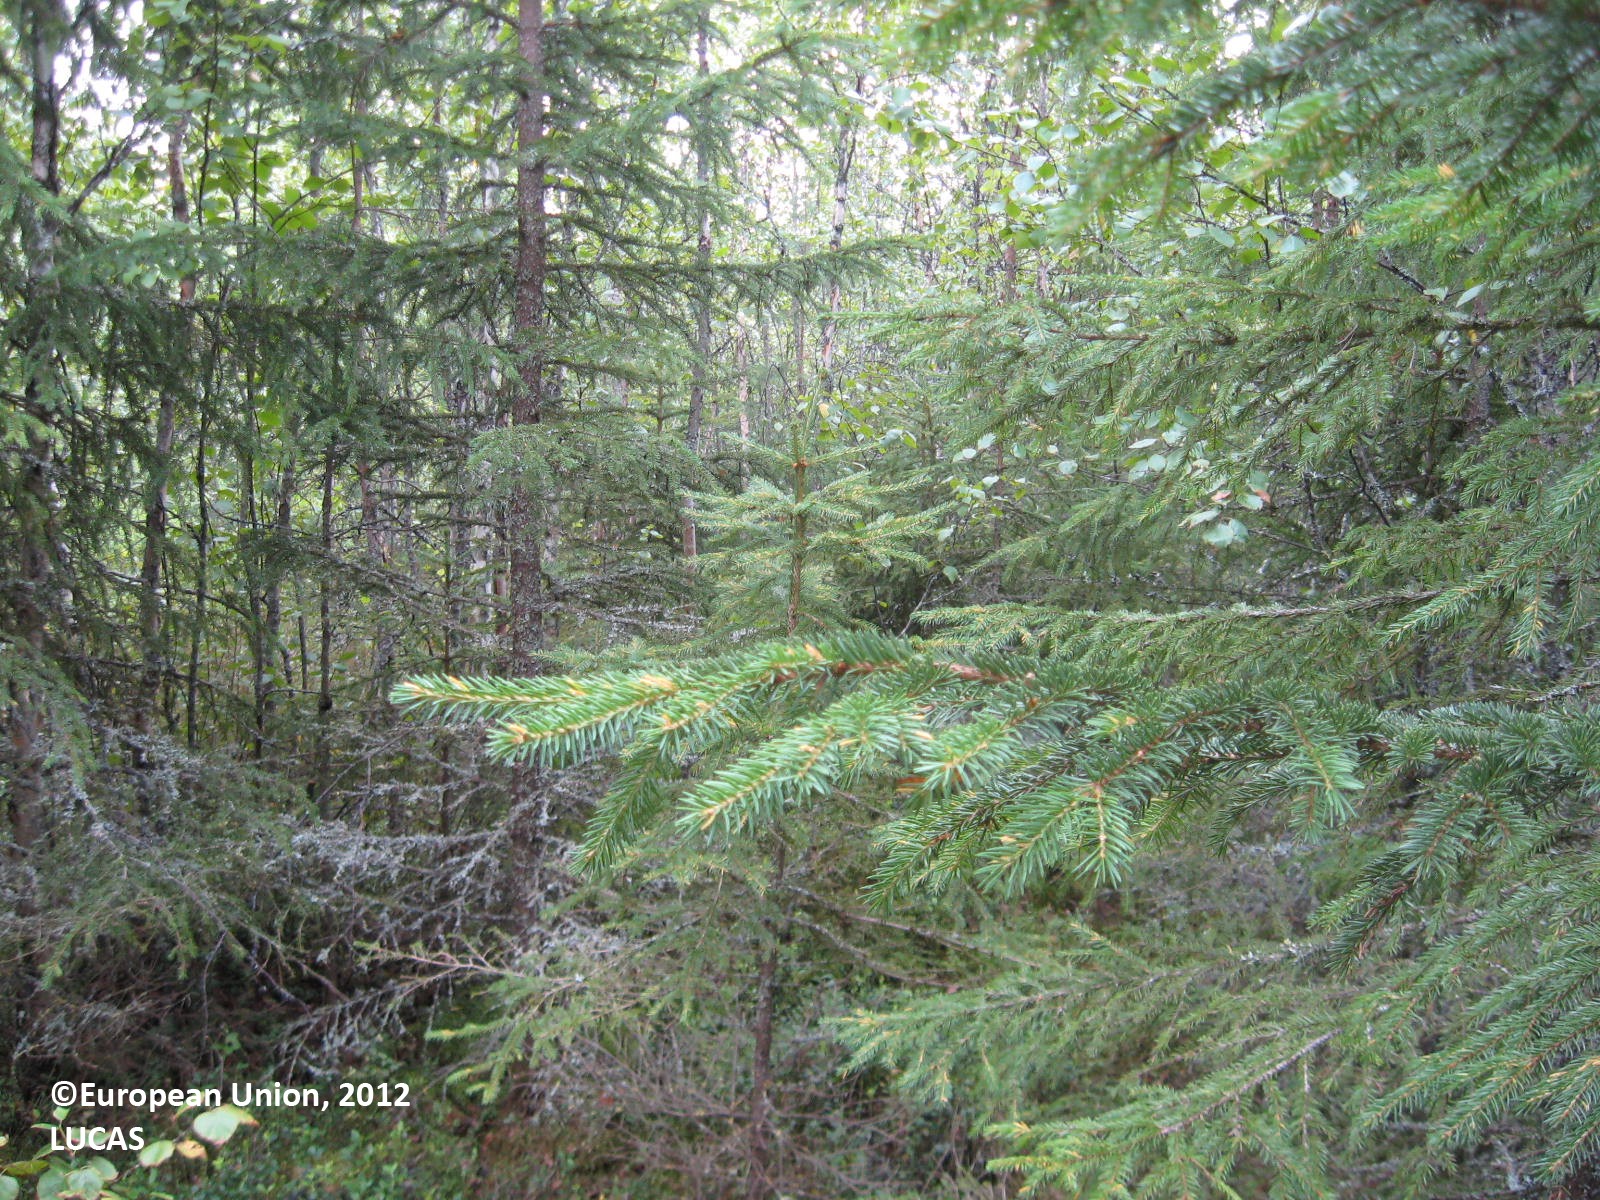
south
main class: Woodland
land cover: Other mixed woodland
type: boreal forest
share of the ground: > 75 %
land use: Forestry
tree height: > 5 m
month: July
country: FI
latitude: 61.8571
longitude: 22.4320
